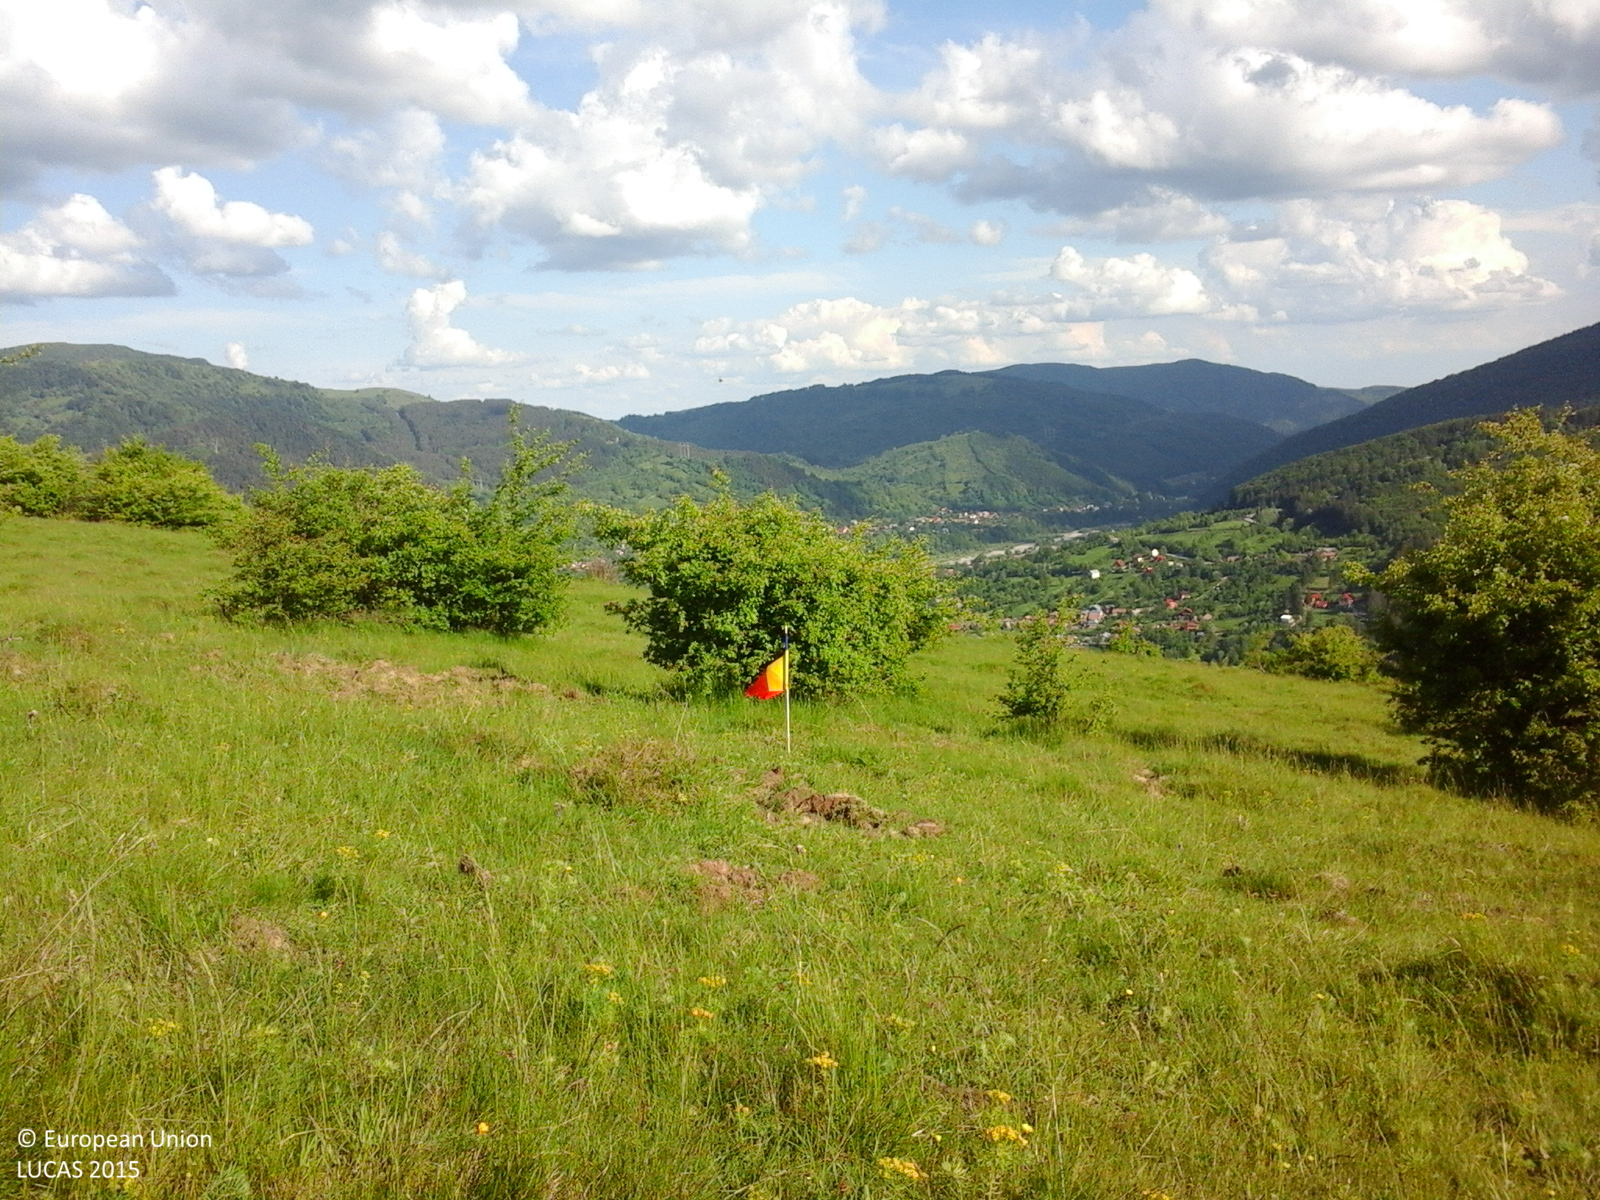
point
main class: Grassland
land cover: Grassland with sparse tree/shrub cover
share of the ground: > 75 %
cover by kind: herbaceous plants 85 %, shrubs 10 %, broadleaved forest trees 5 %
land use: Agriculture (excluding fallow land and kitchen gardens)
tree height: < 5 m
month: May
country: RO
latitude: 45.3105
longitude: 25.7033
